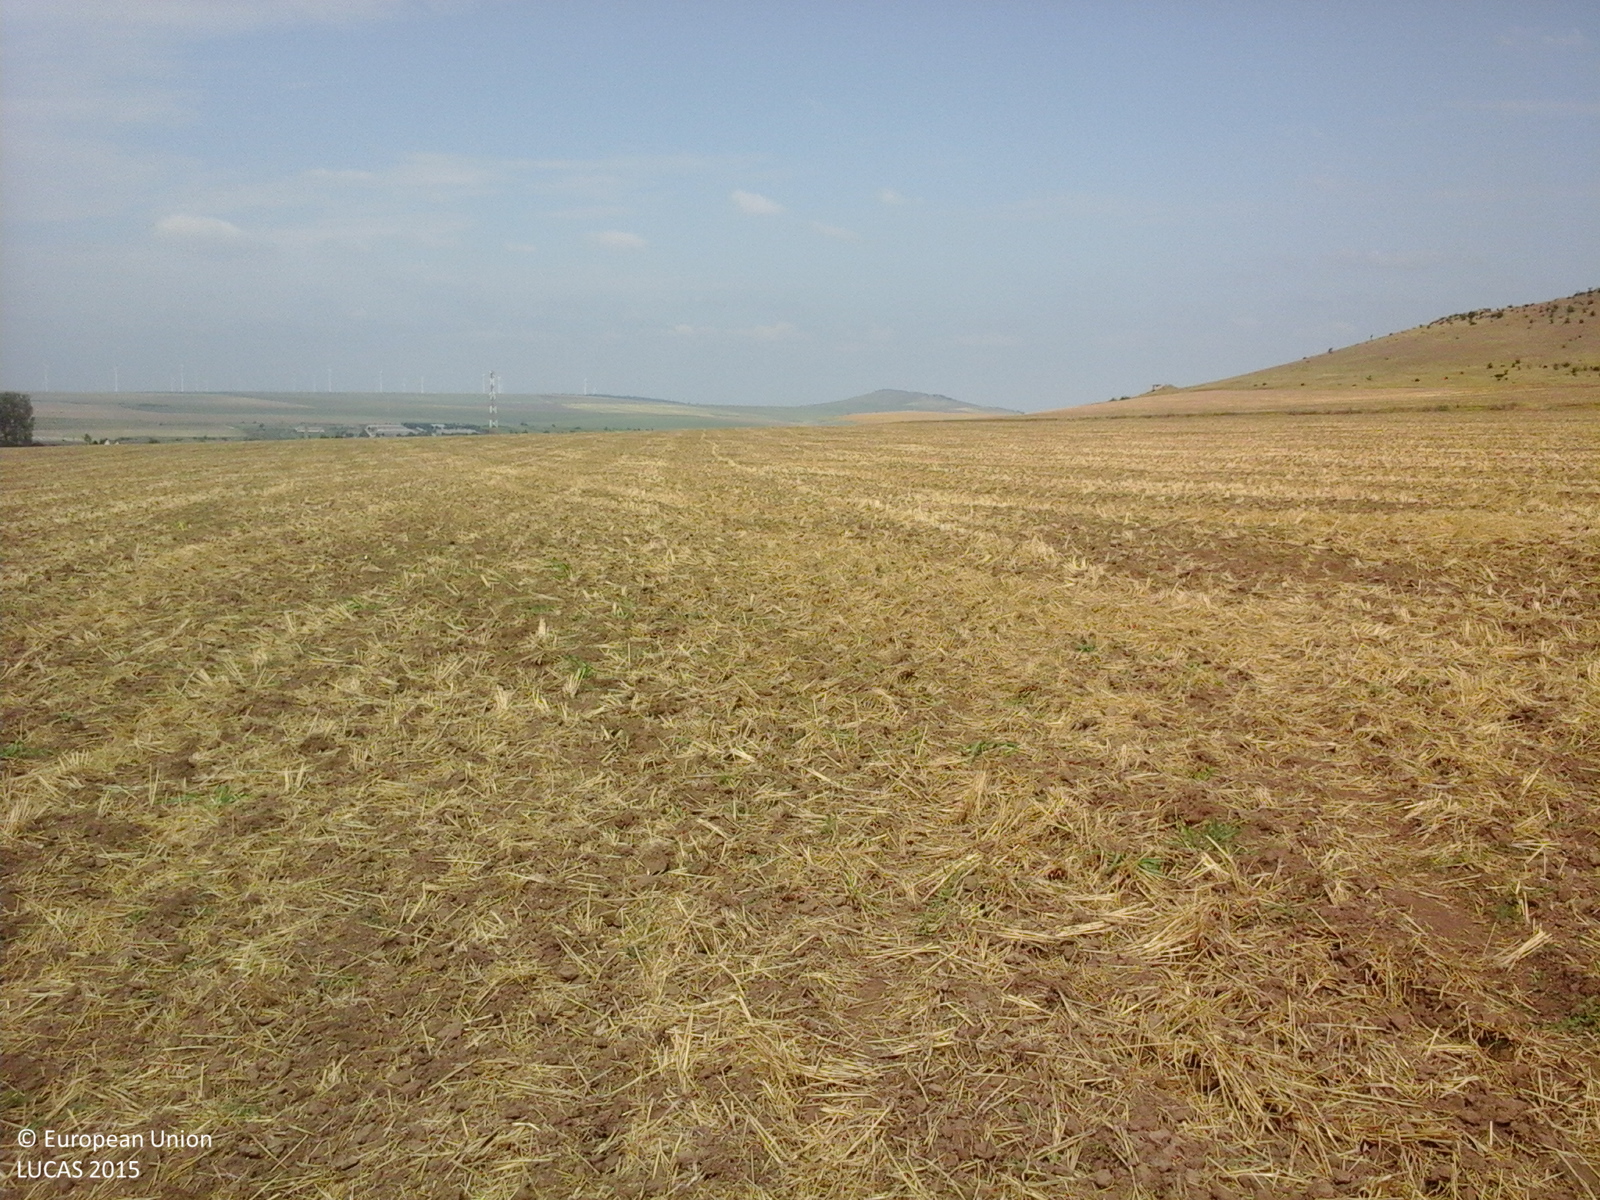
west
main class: Cropland
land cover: Common wheat
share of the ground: 25 - 50 %
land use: Agriculture (excluding fallow land and kitchen gardens)
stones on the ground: < 10 %
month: August
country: RO
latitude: 45.0825
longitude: 29.0392
